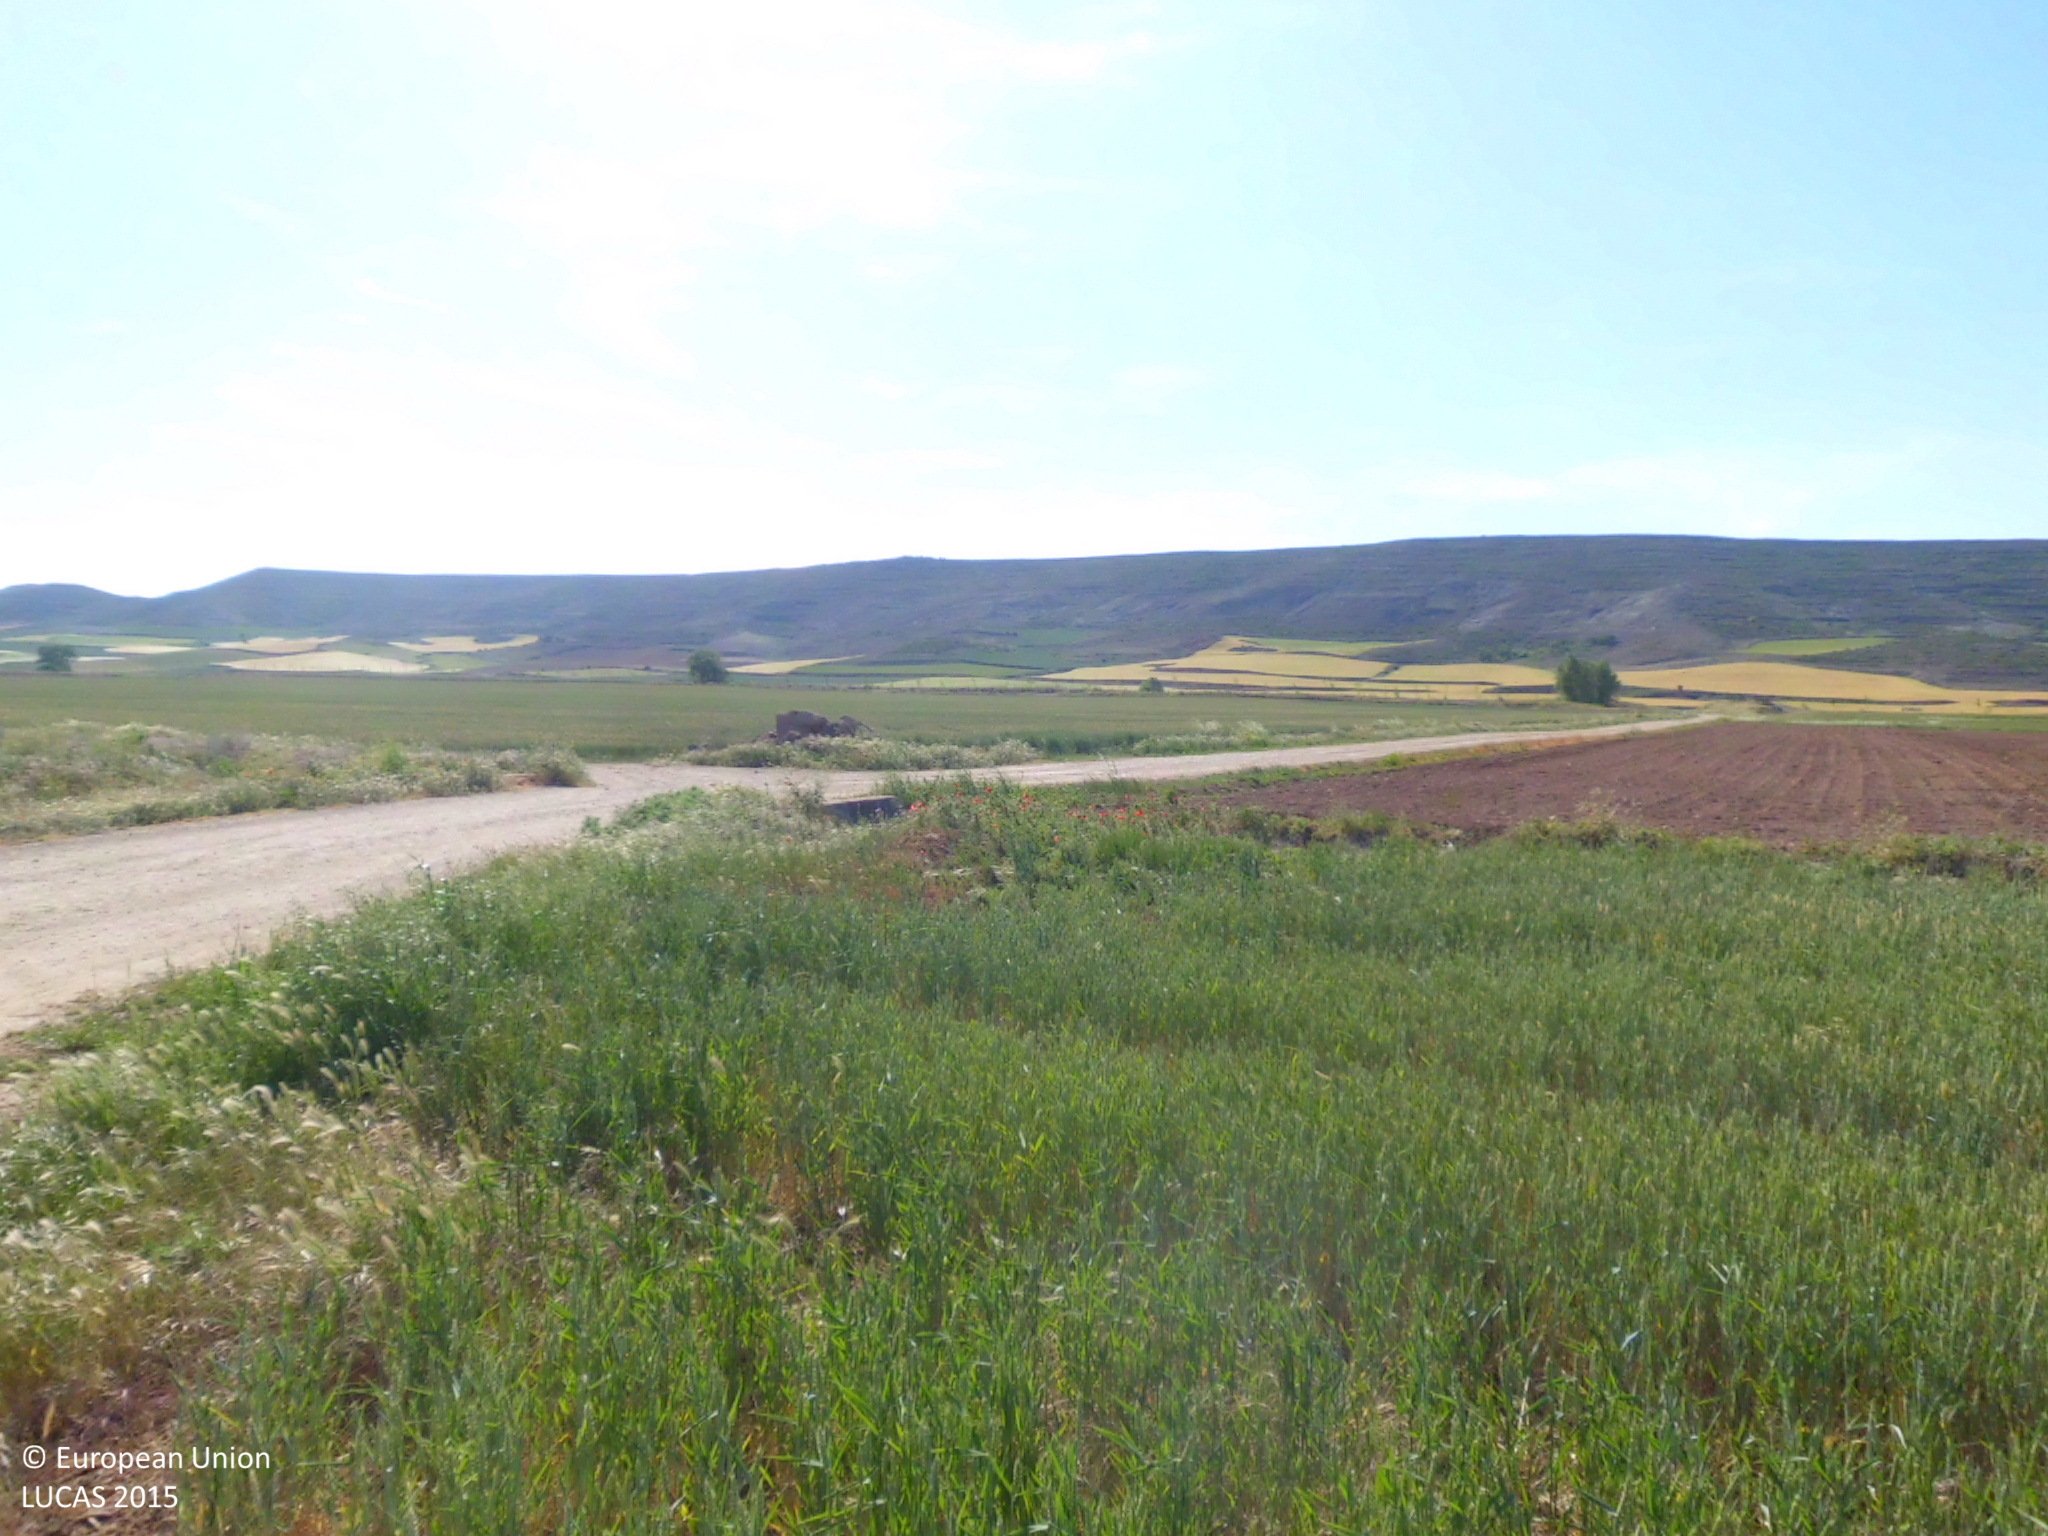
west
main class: Cropland
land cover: Common wheat
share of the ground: > 75 %
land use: Agriculture (excluding fallow land and kitchen gardens)
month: May
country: ES
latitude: 42.2747
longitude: -4.1687
